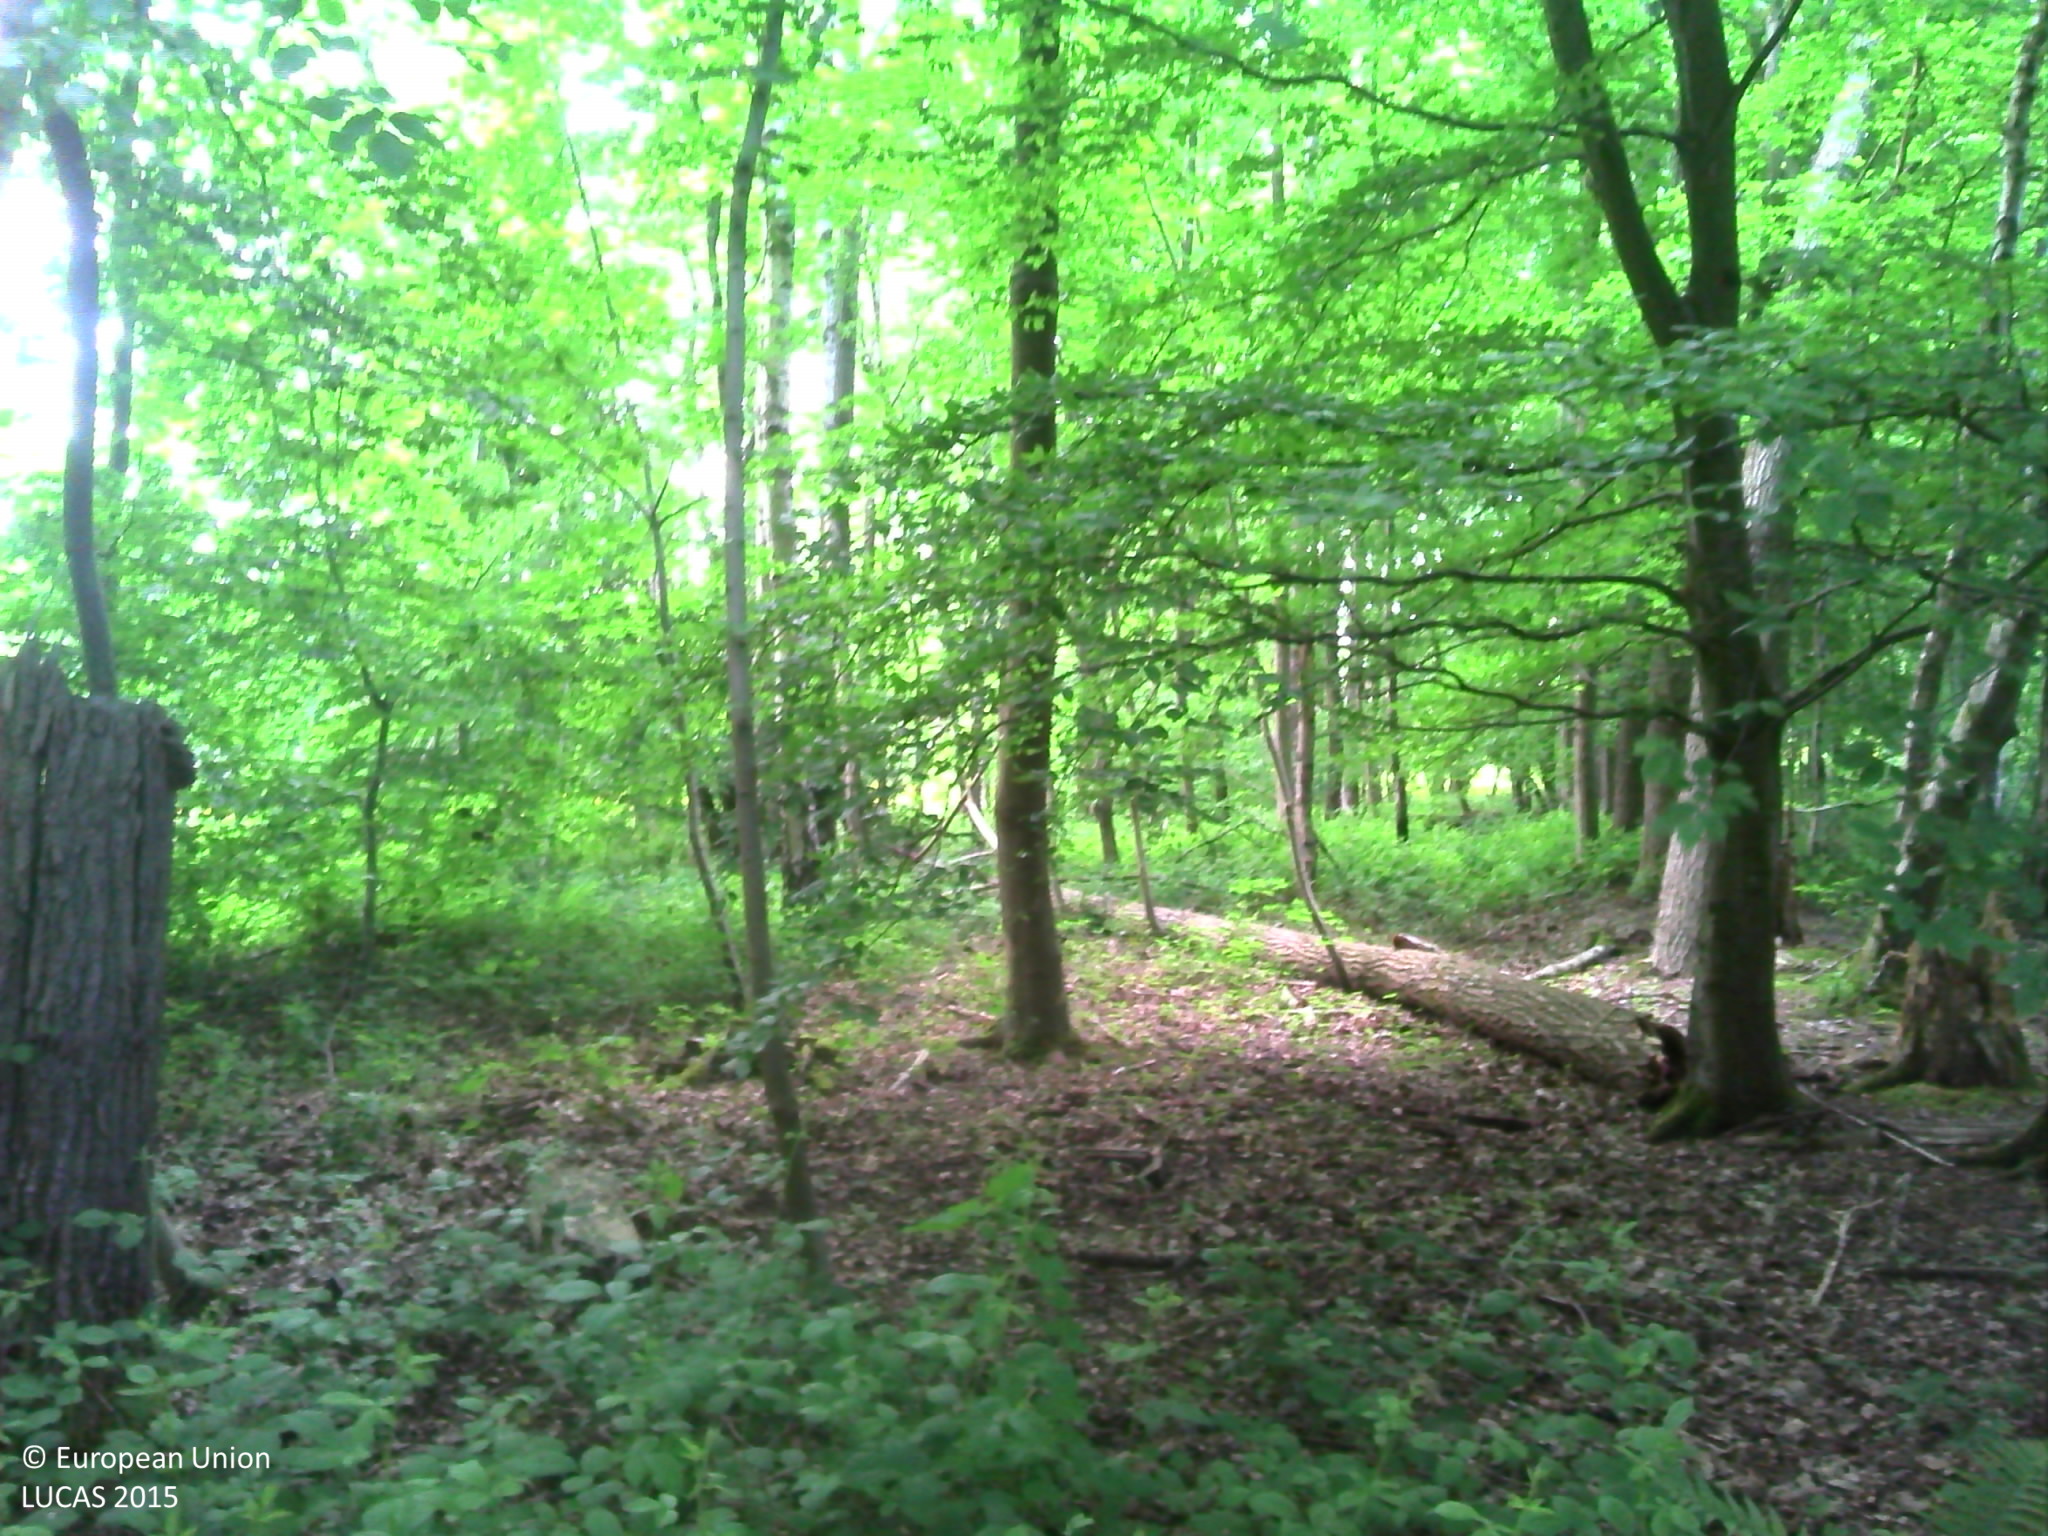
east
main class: Woodland
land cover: Broadleaved woodland
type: mesophytic deciduous forest
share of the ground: > 75 %
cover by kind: broadleaved forest trees 80 %, herbaceous plants 10 %, lichens and mosses 5 %
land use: Forestry
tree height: > 5 m
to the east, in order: Broadleaved woodland; Tracks; Broadleaved woodland; Tracks; Grass margins; Fences; Grassland without tree/shrub cover; Artificial constructions in urban areas
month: May
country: BE
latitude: 50.3761
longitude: 4.8926
